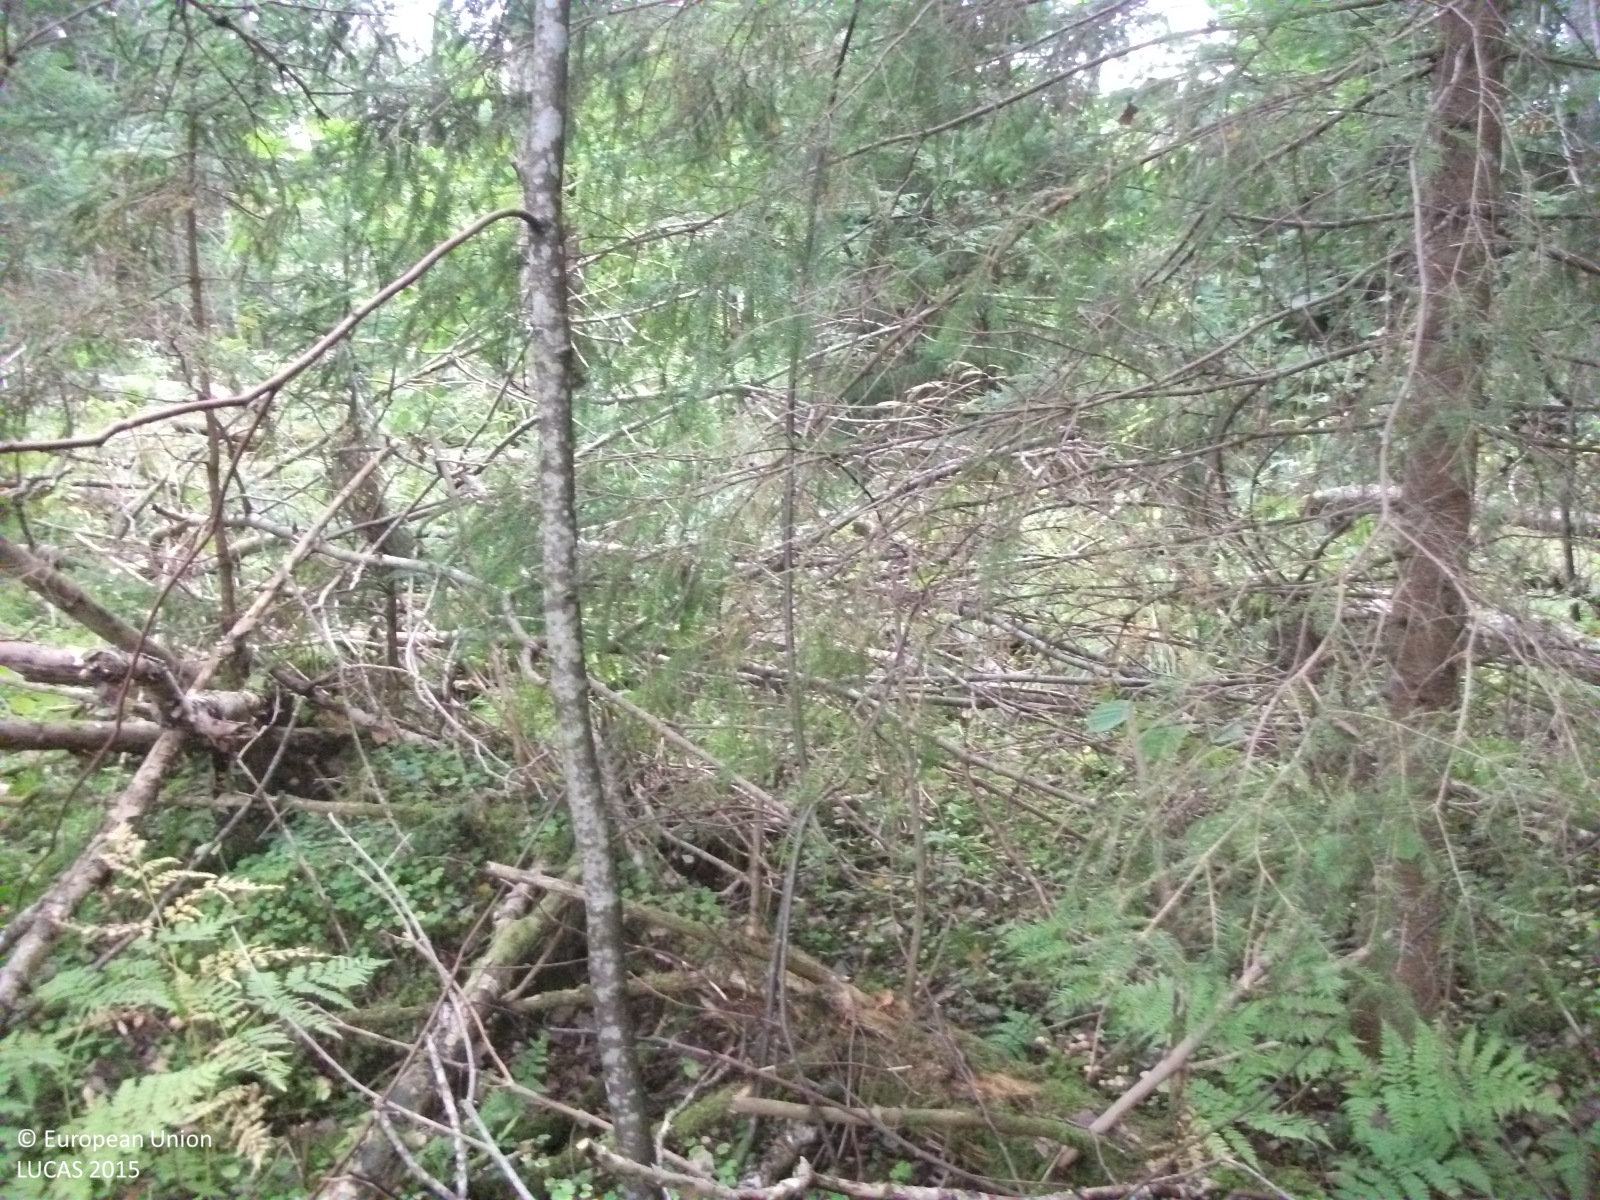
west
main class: Woodland
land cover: Spruce dominated mixed woodland
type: hemiboreal forest and nemoral coniferous forest and mixed broadleaved-coniferous forest
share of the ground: > 75 %
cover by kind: broadleaved forest trees 60 %, coniferous forest trees 25 %, herbaceous plants 10 %, shrubs 5 %
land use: Forestry
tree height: > 5 m
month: September
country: LV
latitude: 57.7783
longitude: 24.6379
